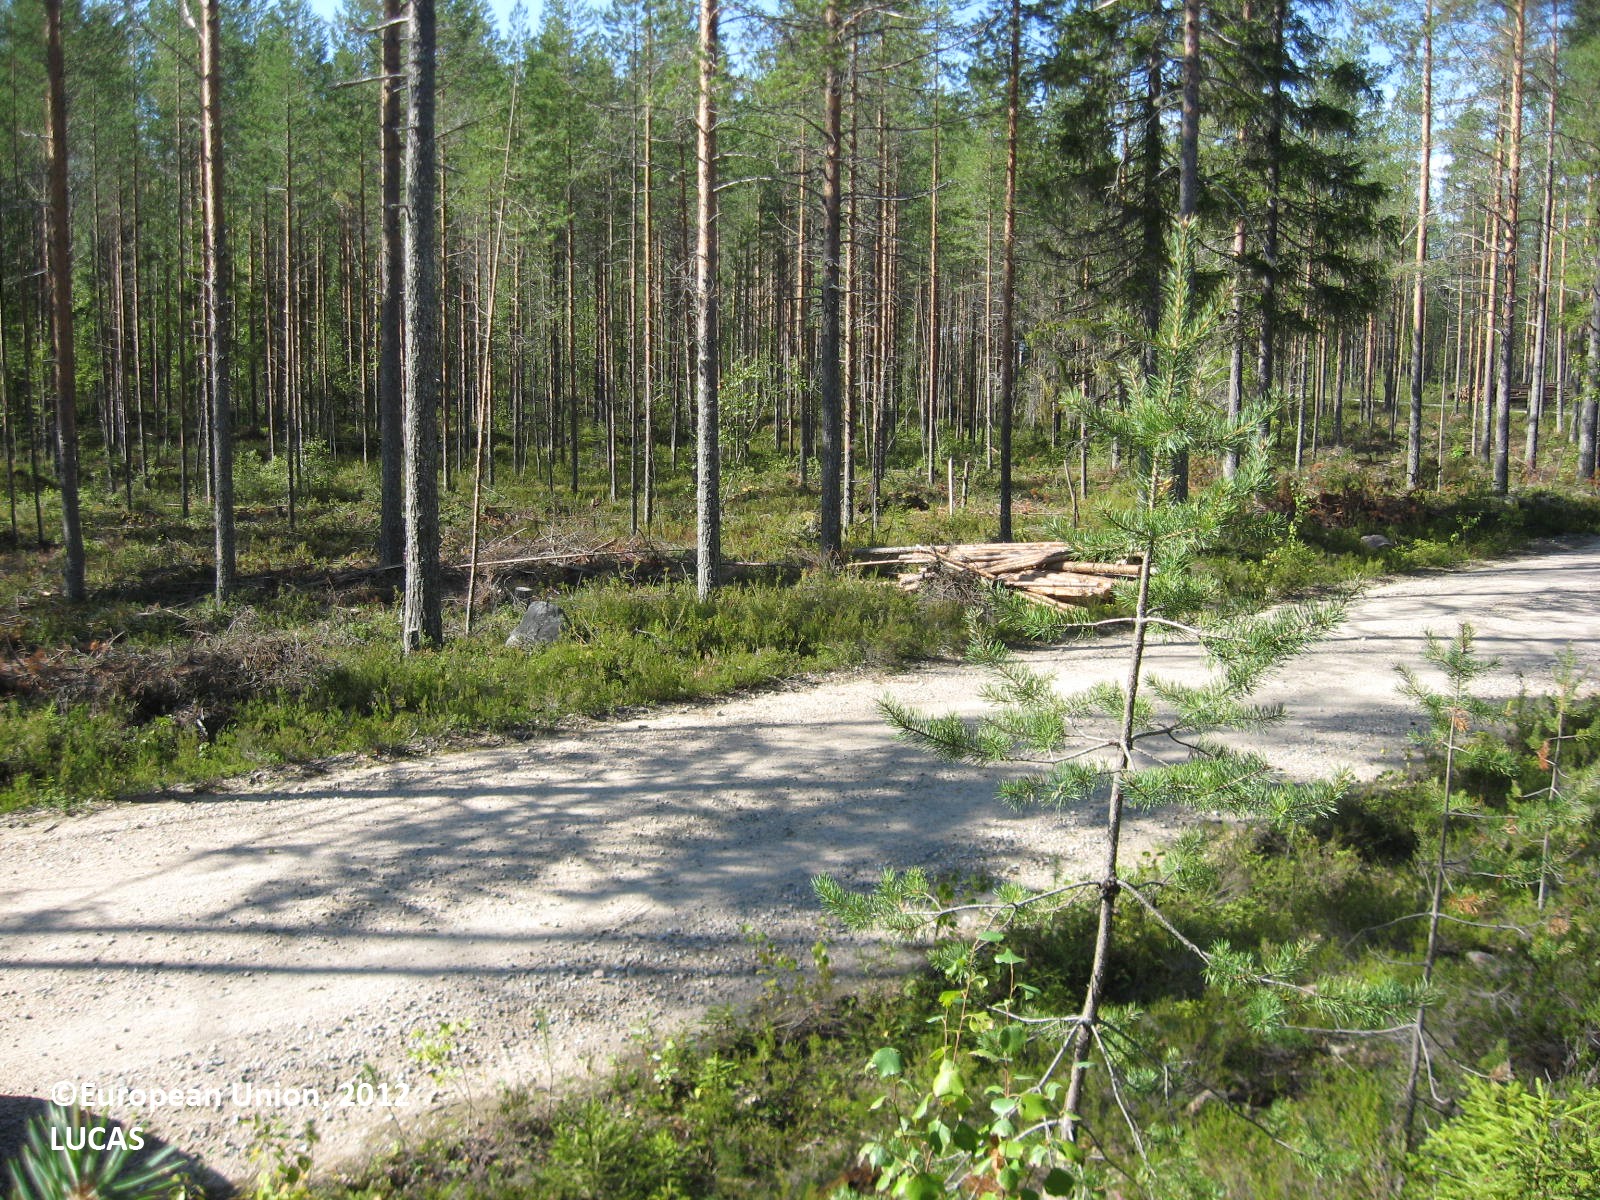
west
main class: Woodland
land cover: Pine dominated coniferous woodland
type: boreal forest
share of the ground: > 75 %
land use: Forestry
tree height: > 5 m
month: August
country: FI
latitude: 63.6475
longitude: 29.8458
